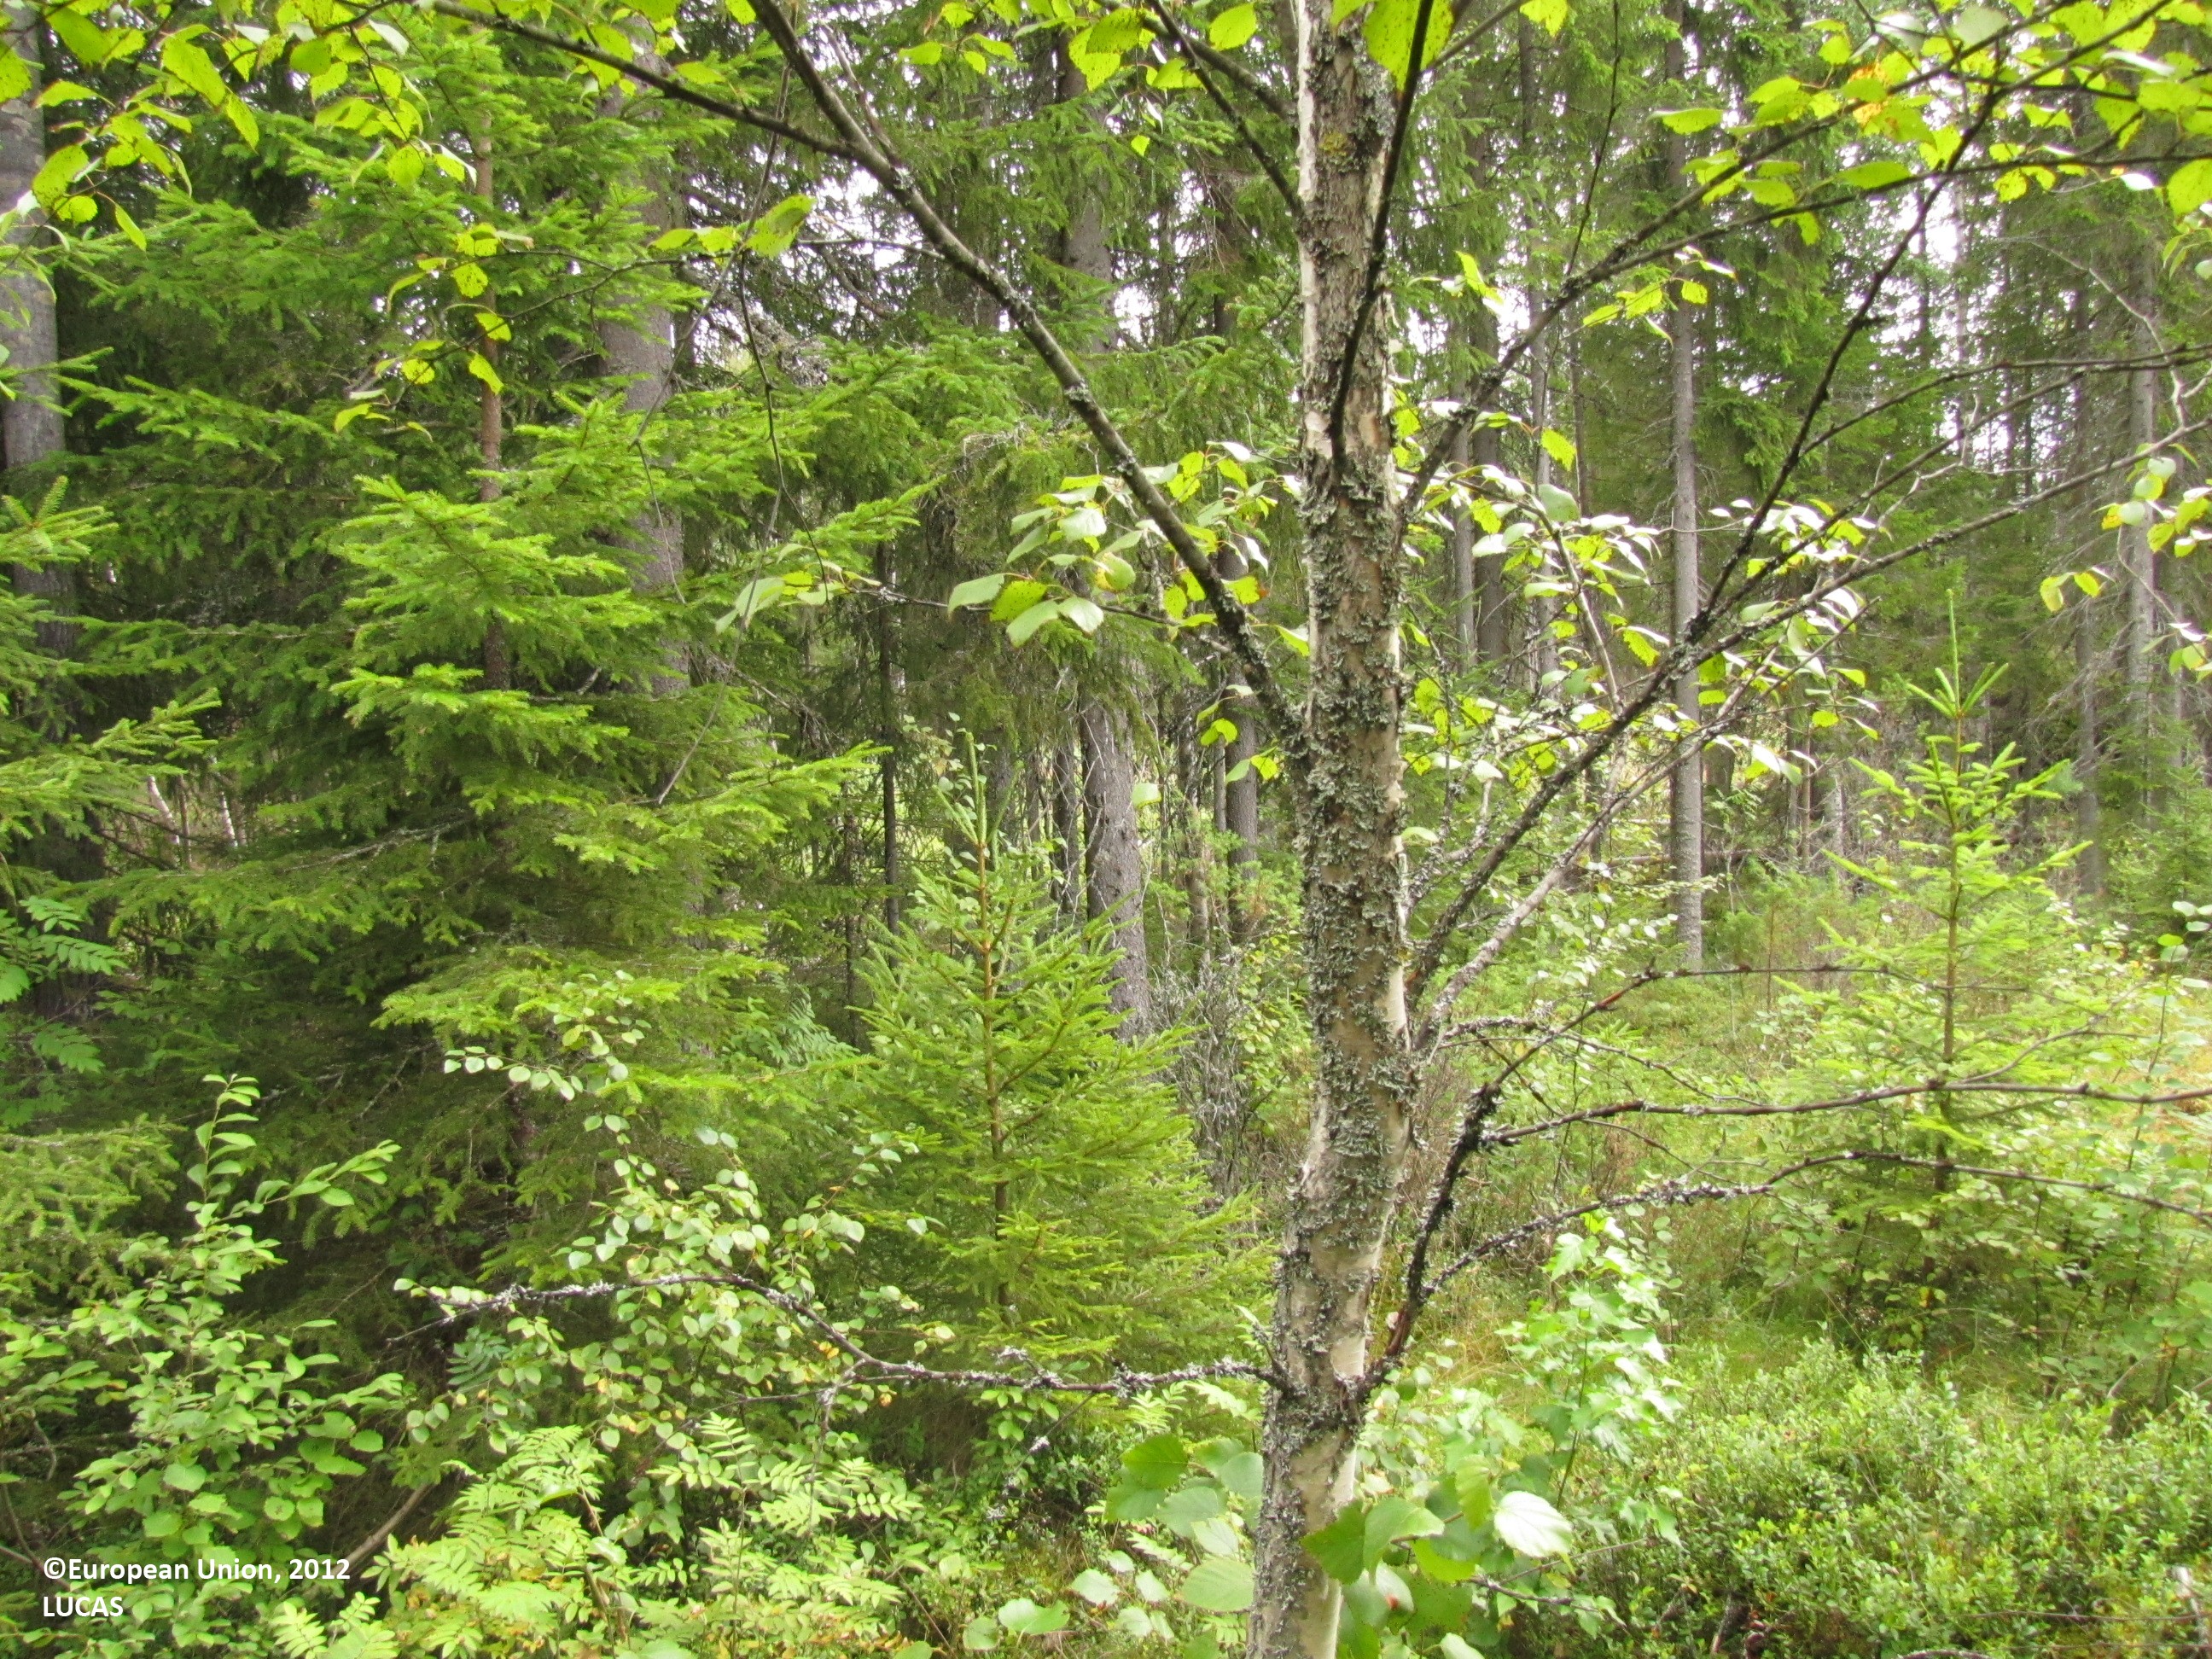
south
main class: Woodland
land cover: Pine dominated mixed woodland
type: boreal forest
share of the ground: 25 - 50 %
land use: Forestry
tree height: < 5 m
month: August
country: FI
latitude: 61.8692
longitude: 23.1318
